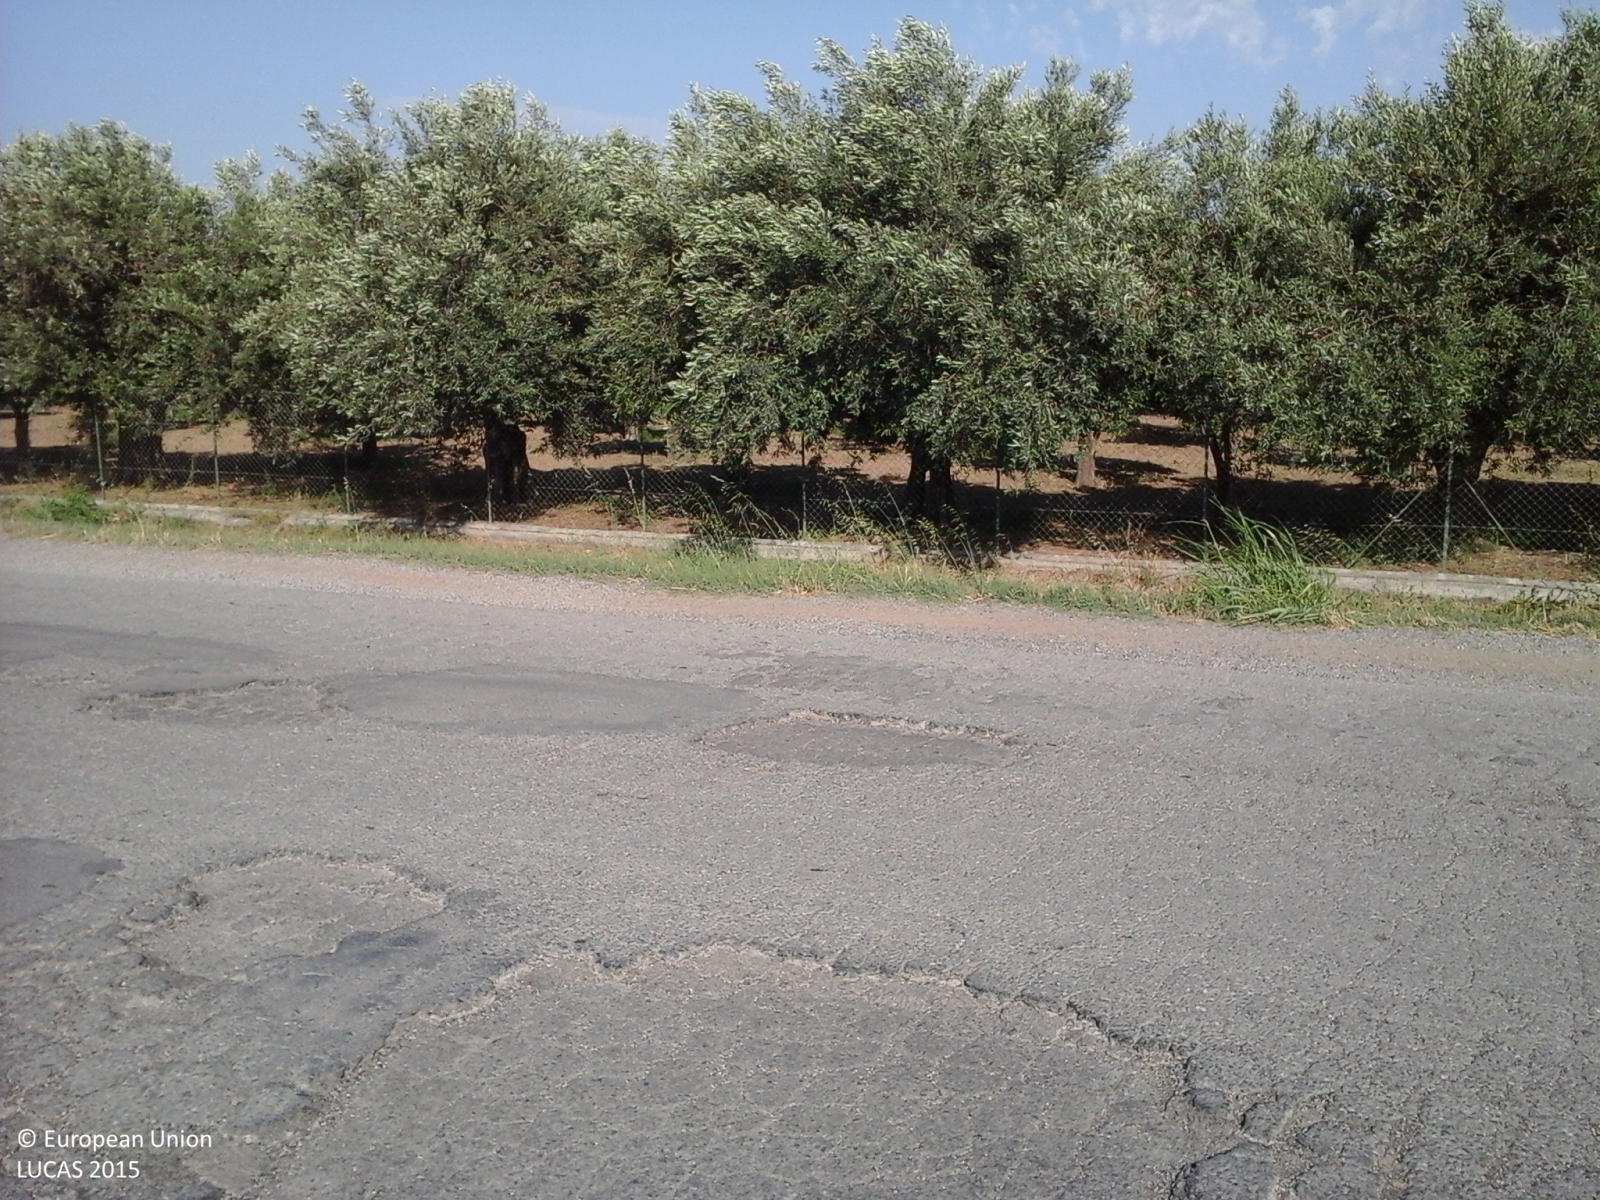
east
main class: Cropland
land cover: Common wheat
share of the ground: > 75 %
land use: Agriculture (excluding fallow land and kitchen gardens)
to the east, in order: Common wheat; Grass margins; Tracks; Other bare soil; Grass margins; Ditches and canals; Grass margins; Fences; Oranges; Fences; Ditches and canals; Grass margins; Paved roads, cycling and walking lanes; Grass margins; Ditches and canals; Grass margins; Oranges
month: June
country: IT
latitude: 37.4064
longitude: 14.8336
